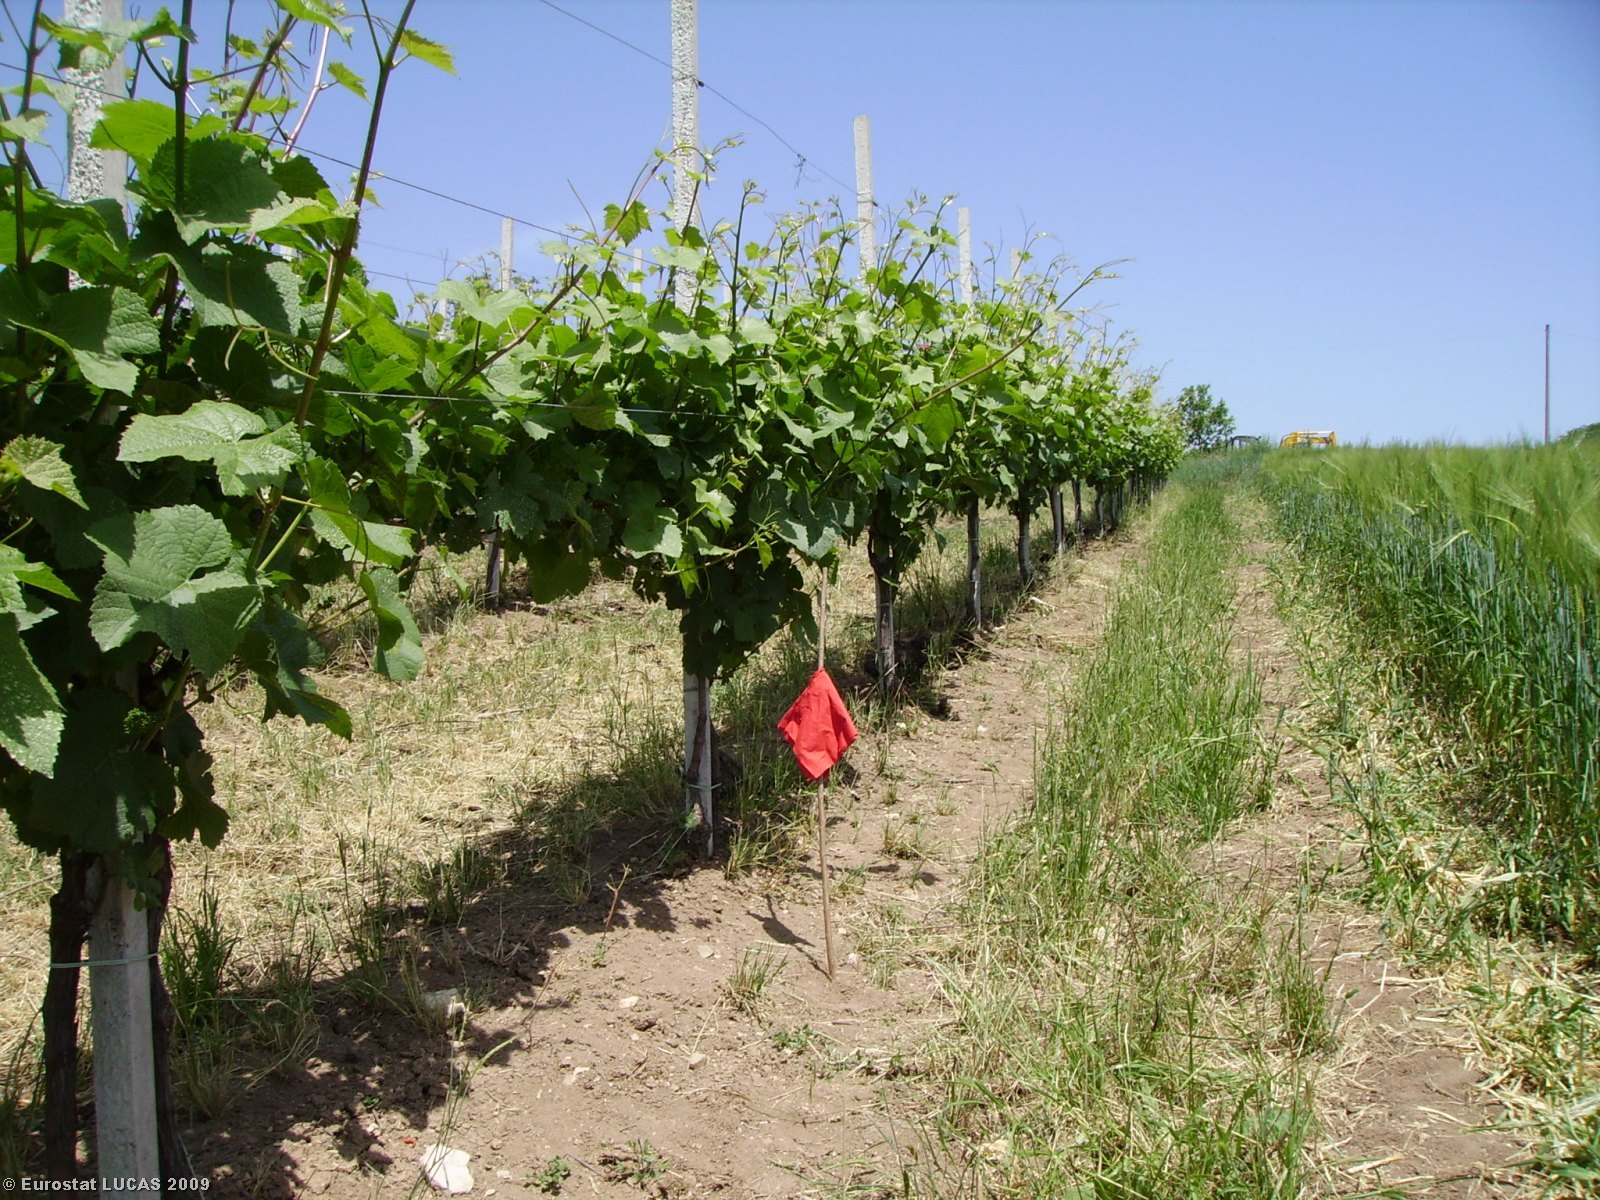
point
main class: Cropland
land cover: Vineyards
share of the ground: 50 - 75 %
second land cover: Grassland with sparse tree/shrub cover
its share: 50 - 75 %
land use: Agriculture (excluding fallow land and kitchen gardens)
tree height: < 5 m
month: May
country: IT
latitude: 44.9251
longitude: 9.2793
